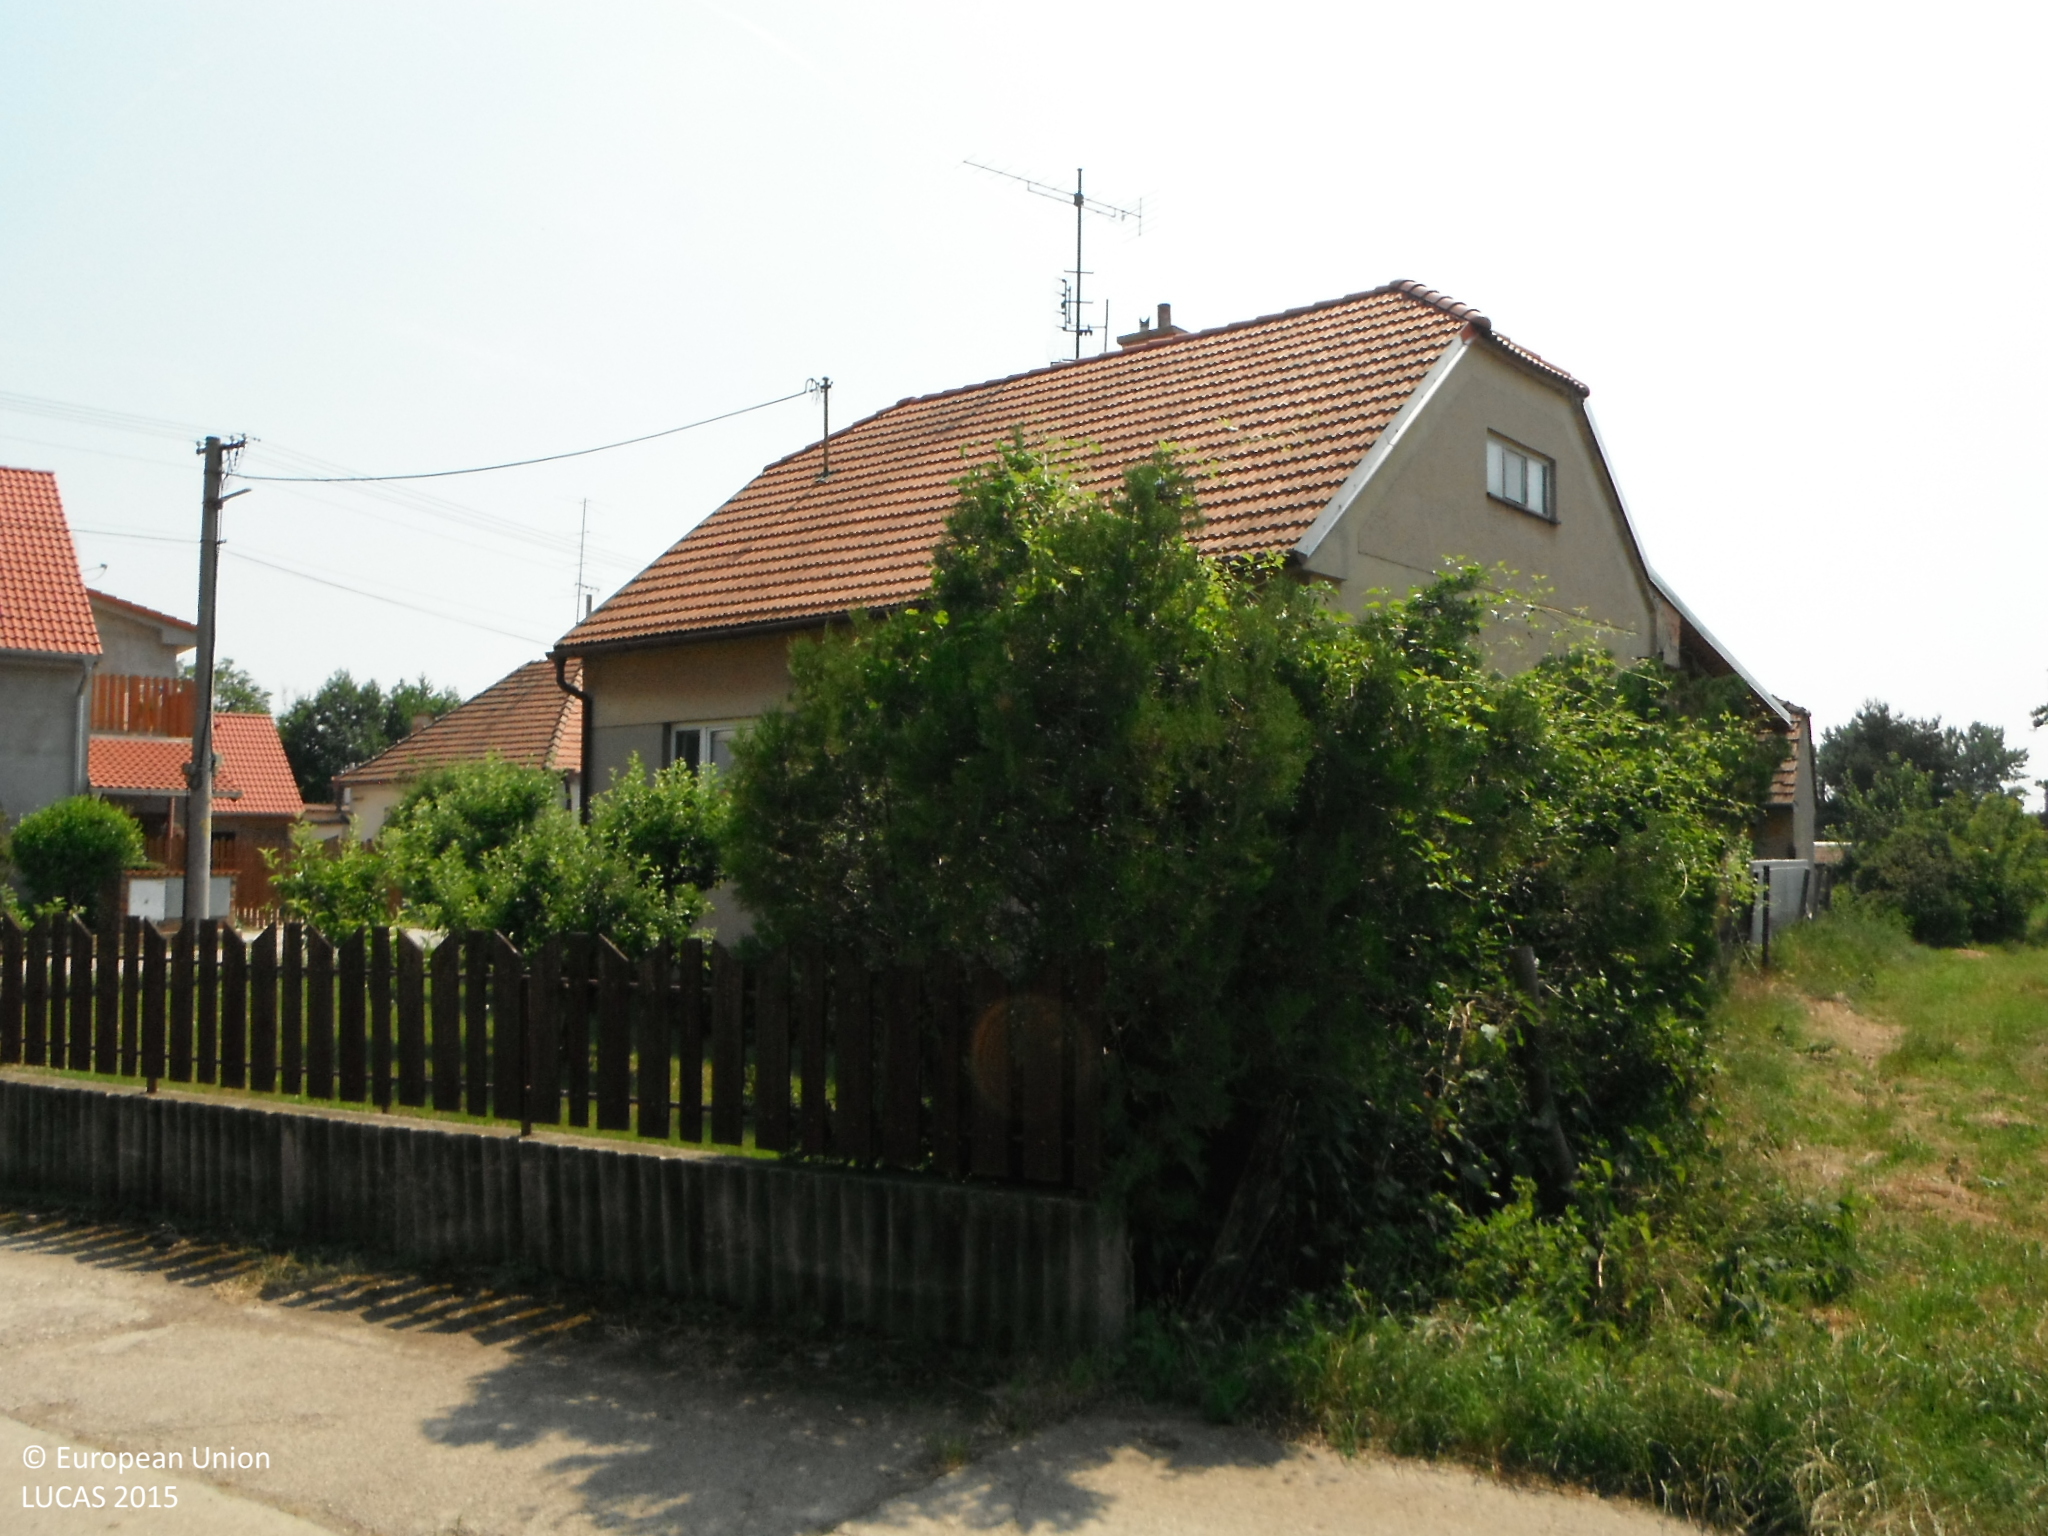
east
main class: Grassland
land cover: Grassland with sparse tree/shrub cover
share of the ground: > 75 %
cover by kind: herbaceous plants 90 %, broadleaved forest trees 5 %, shrubs 5 %
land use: Abandoned areas
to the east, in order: Grassland with sparse tree/shrub cover; Artificial constructions in urban areas; Broadleaved woodland; Inland fresh running water; Broadleaved woodland; Artificial constructions in urban areas
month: June
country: SK
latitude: 48.4011
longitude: 17.5071
